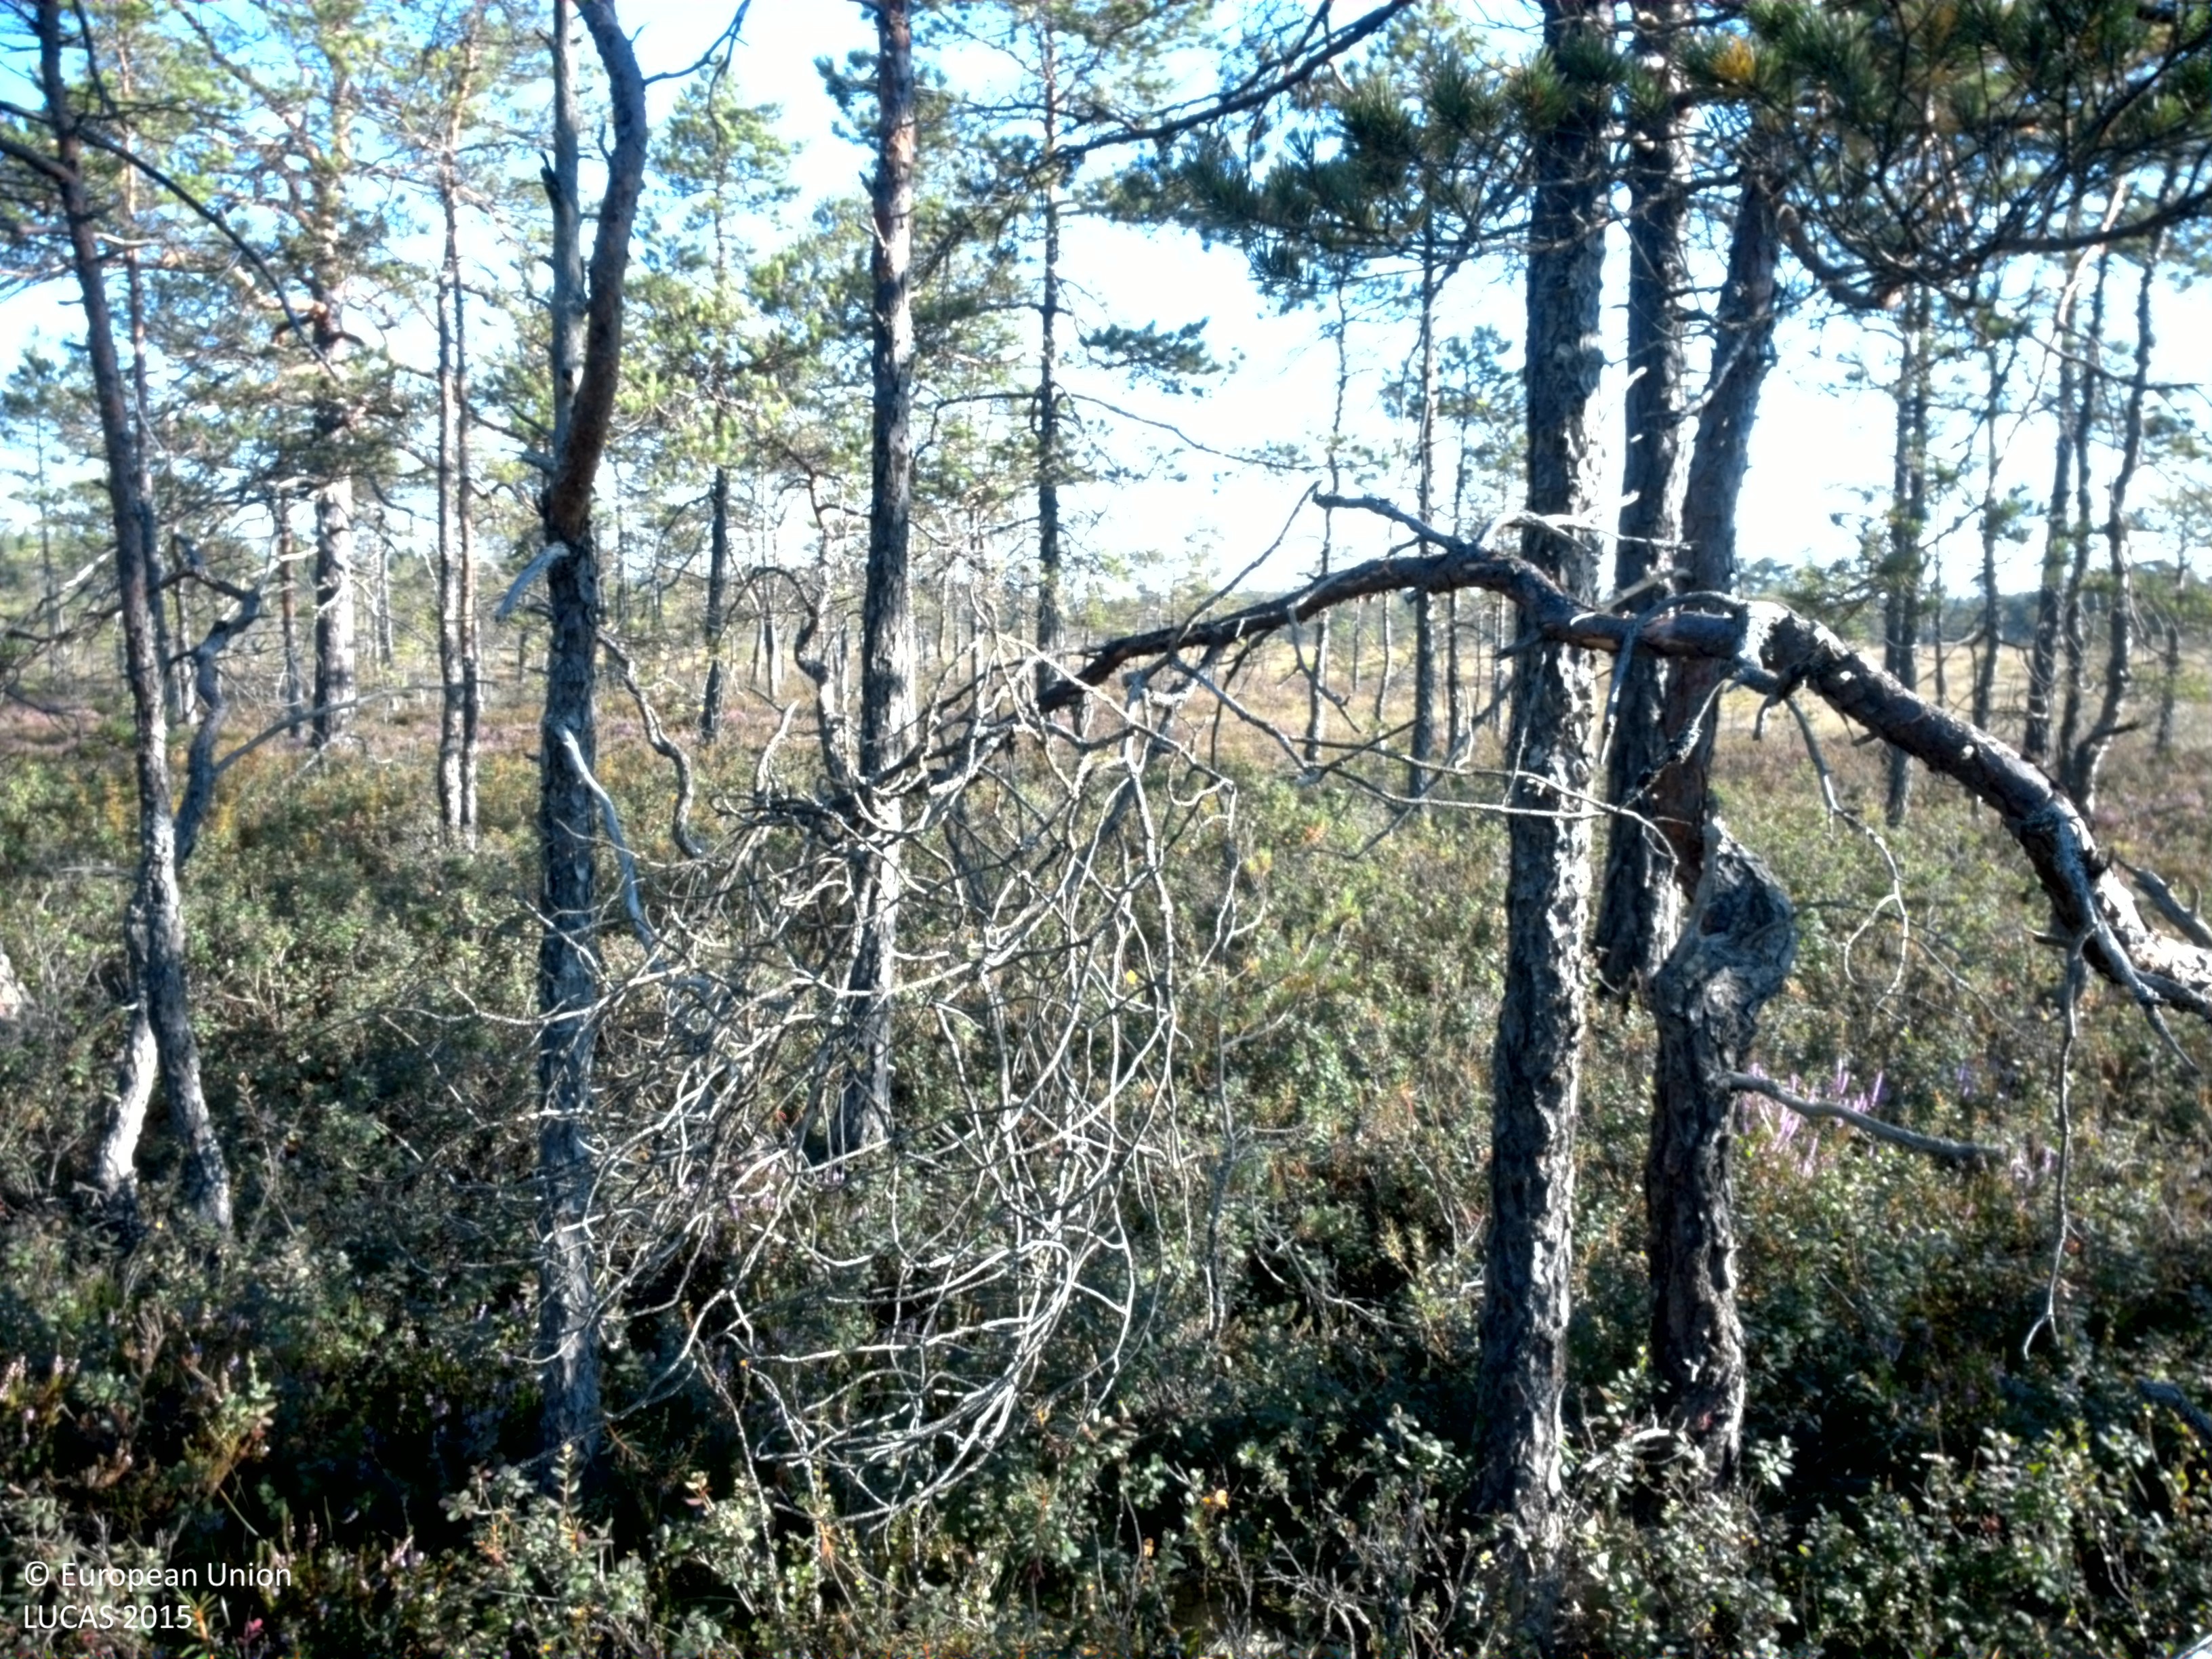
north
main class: Woodland
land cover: Pine dominated coniferous woodland
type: mire and swamp forests
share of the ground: 25 - 50 %
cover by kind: shrubs 50 %, coniferous forest trees 45 %, lichens and mosses 5 %
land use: Semi-natural and natural areas not in use
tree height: < 5 m
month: August
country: SE
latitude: 59.7645
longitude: 15.9906
